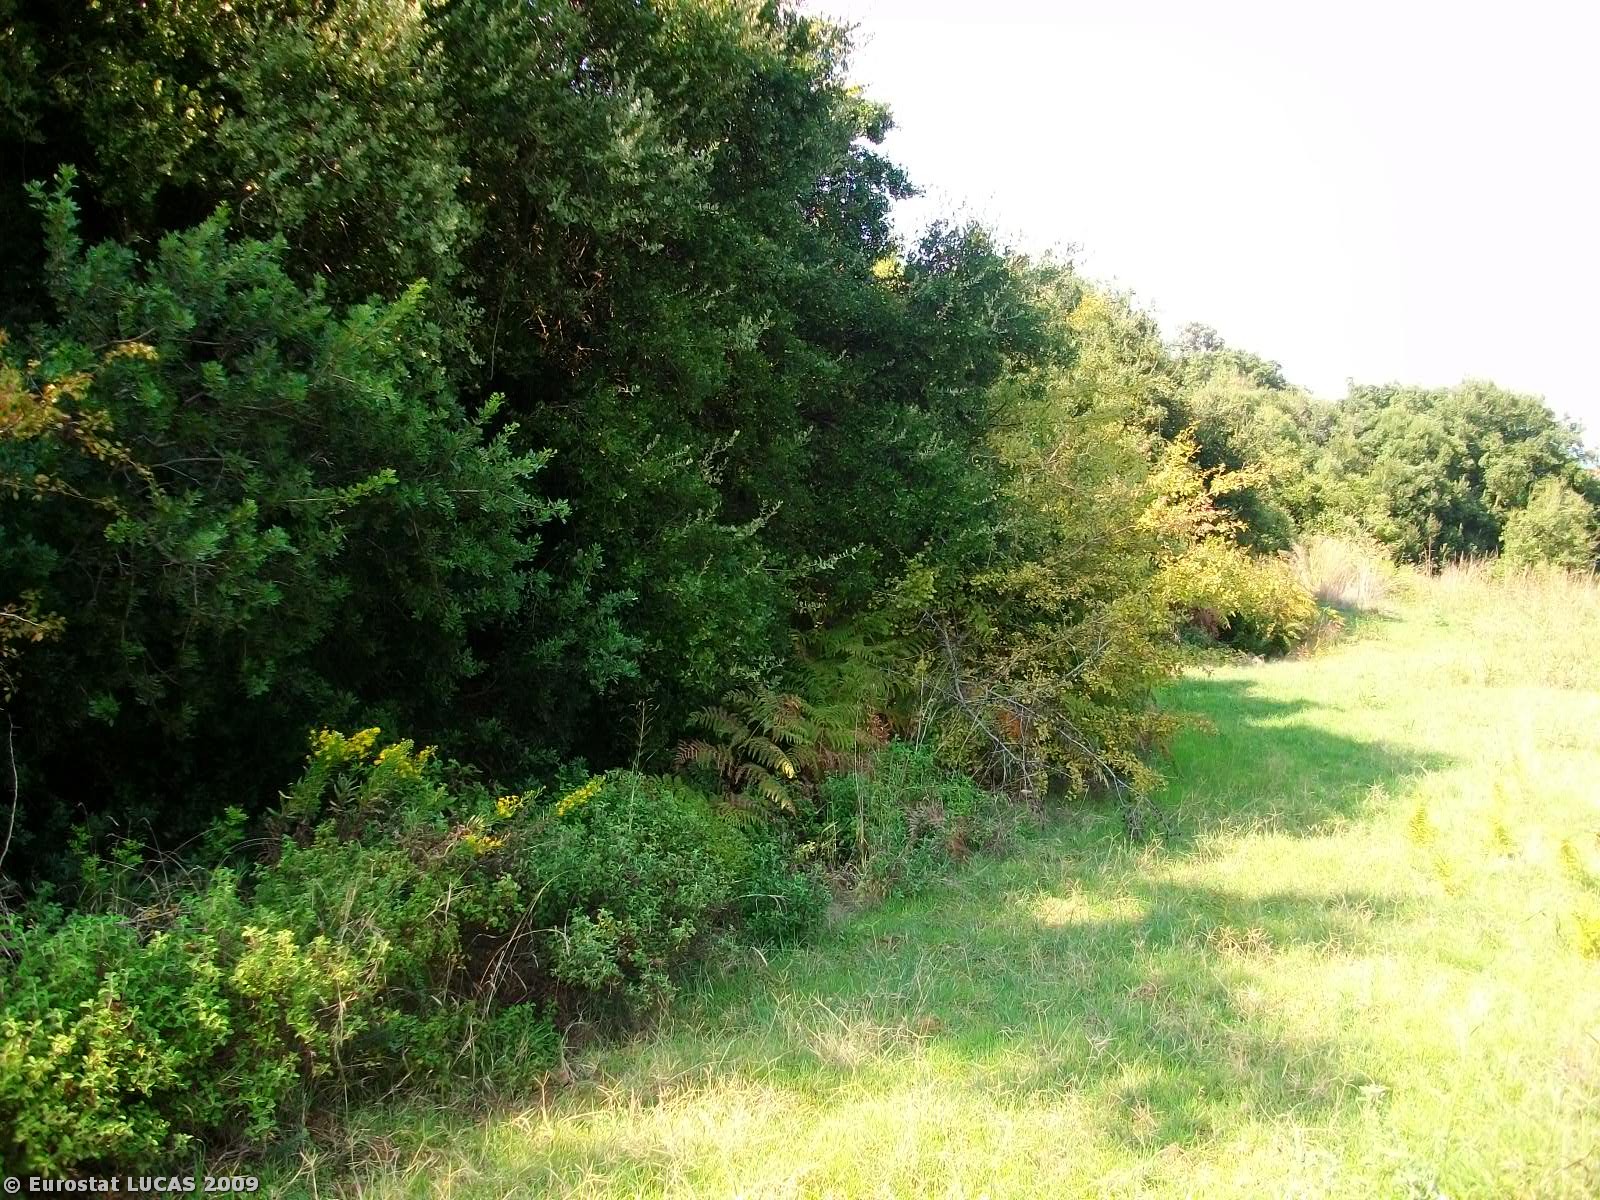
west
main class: Grassland
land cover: Grassland with sparse tree/shrub cover
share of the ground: > 75 %
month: September
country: GR
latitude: 37.7562
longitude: 21.3893
